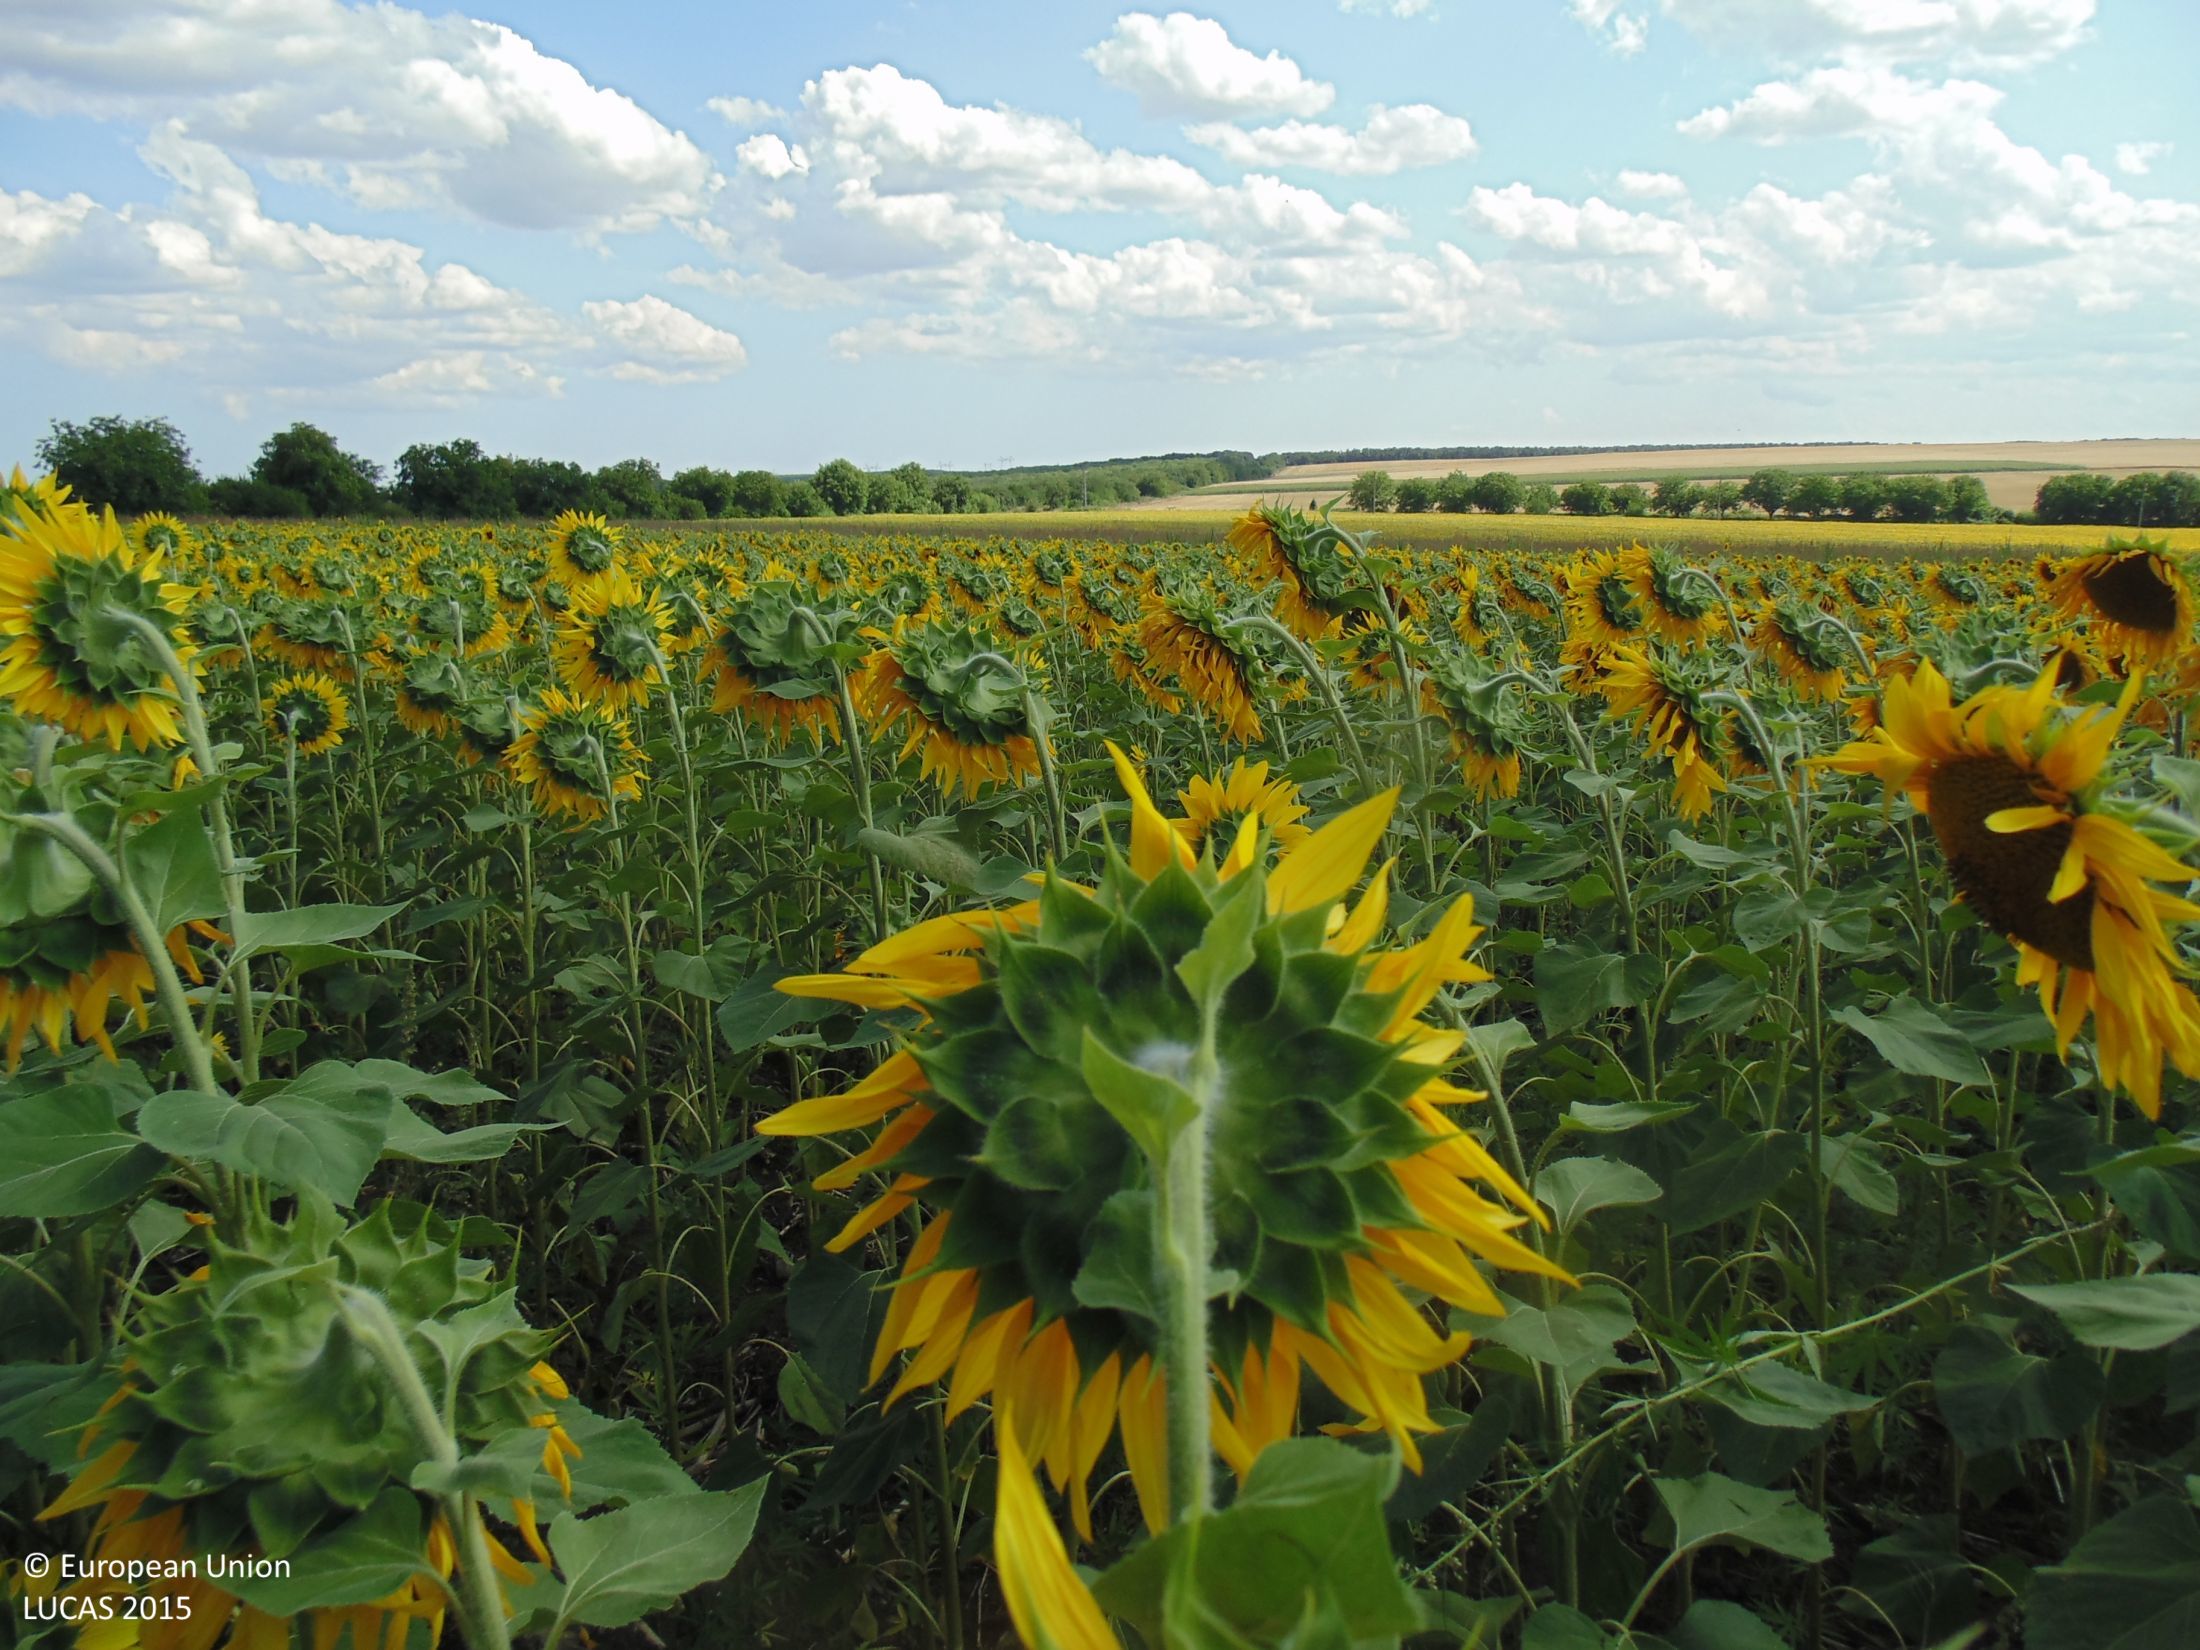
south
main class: Cropland
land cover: Sunflower
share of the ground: > 75 %
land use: Agriculture (excluding fallow land and kitchen gardens)
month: July
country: BG
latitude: 43.5595
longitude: 27.6533
